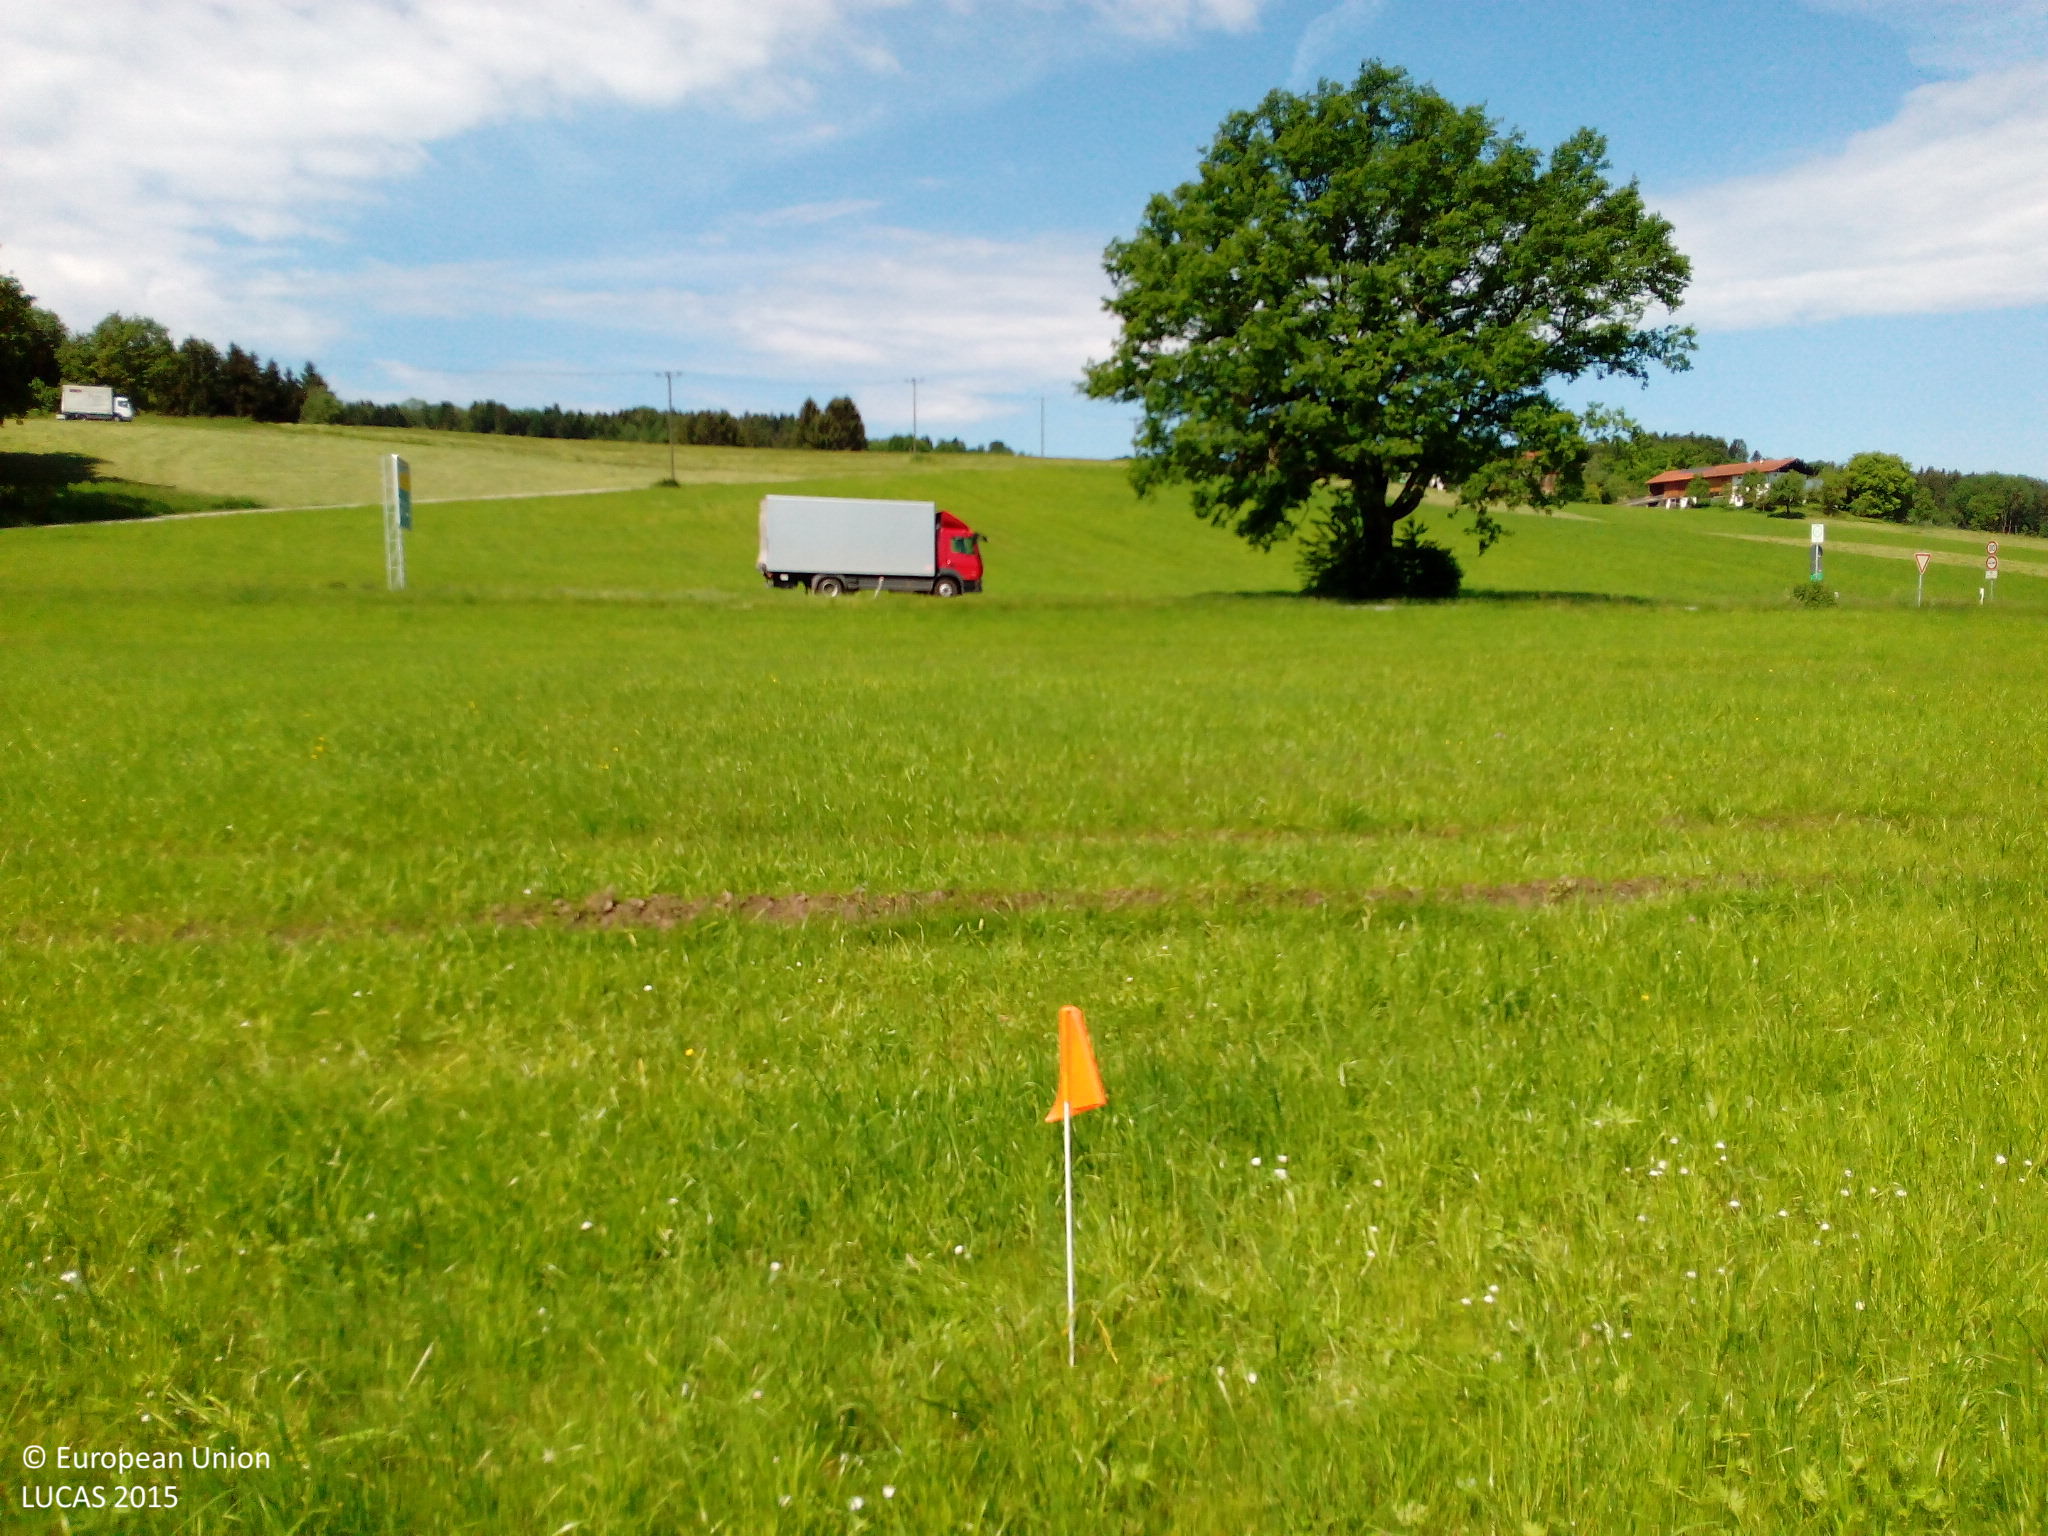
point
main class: Grassland
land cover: Grassland without tree/shrub cover
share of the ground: > 75 %
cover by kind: herbaceous plants 100 %
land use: Agriculture (excluding fallow land and kitchen gardens)
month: June
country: DE
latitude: 47.8202
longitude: 12.3627
